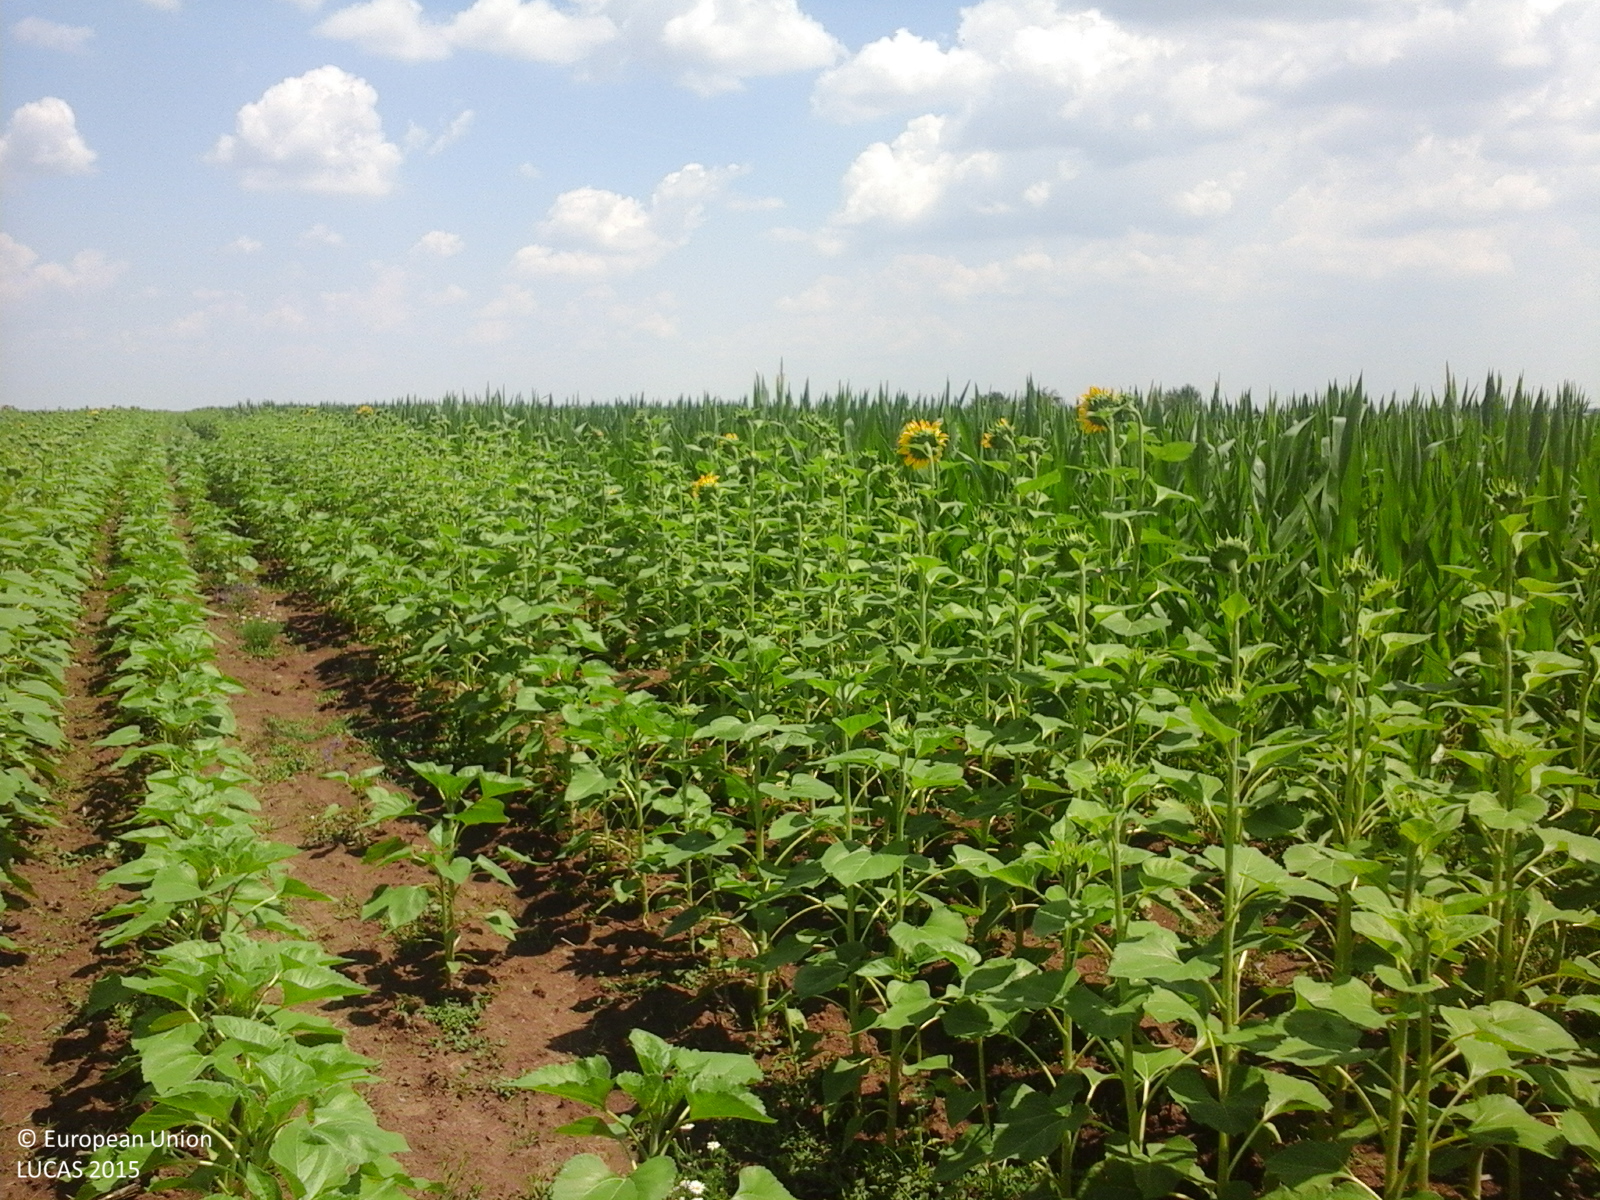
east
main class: Cropland
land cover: Sunflower
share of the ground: > 75 %
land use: Agriculture (excluding fallow land and kitchen gardens)
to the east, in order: Sunflower; Maize
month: July
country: RO
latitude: 44.1013
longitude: 25.2096
